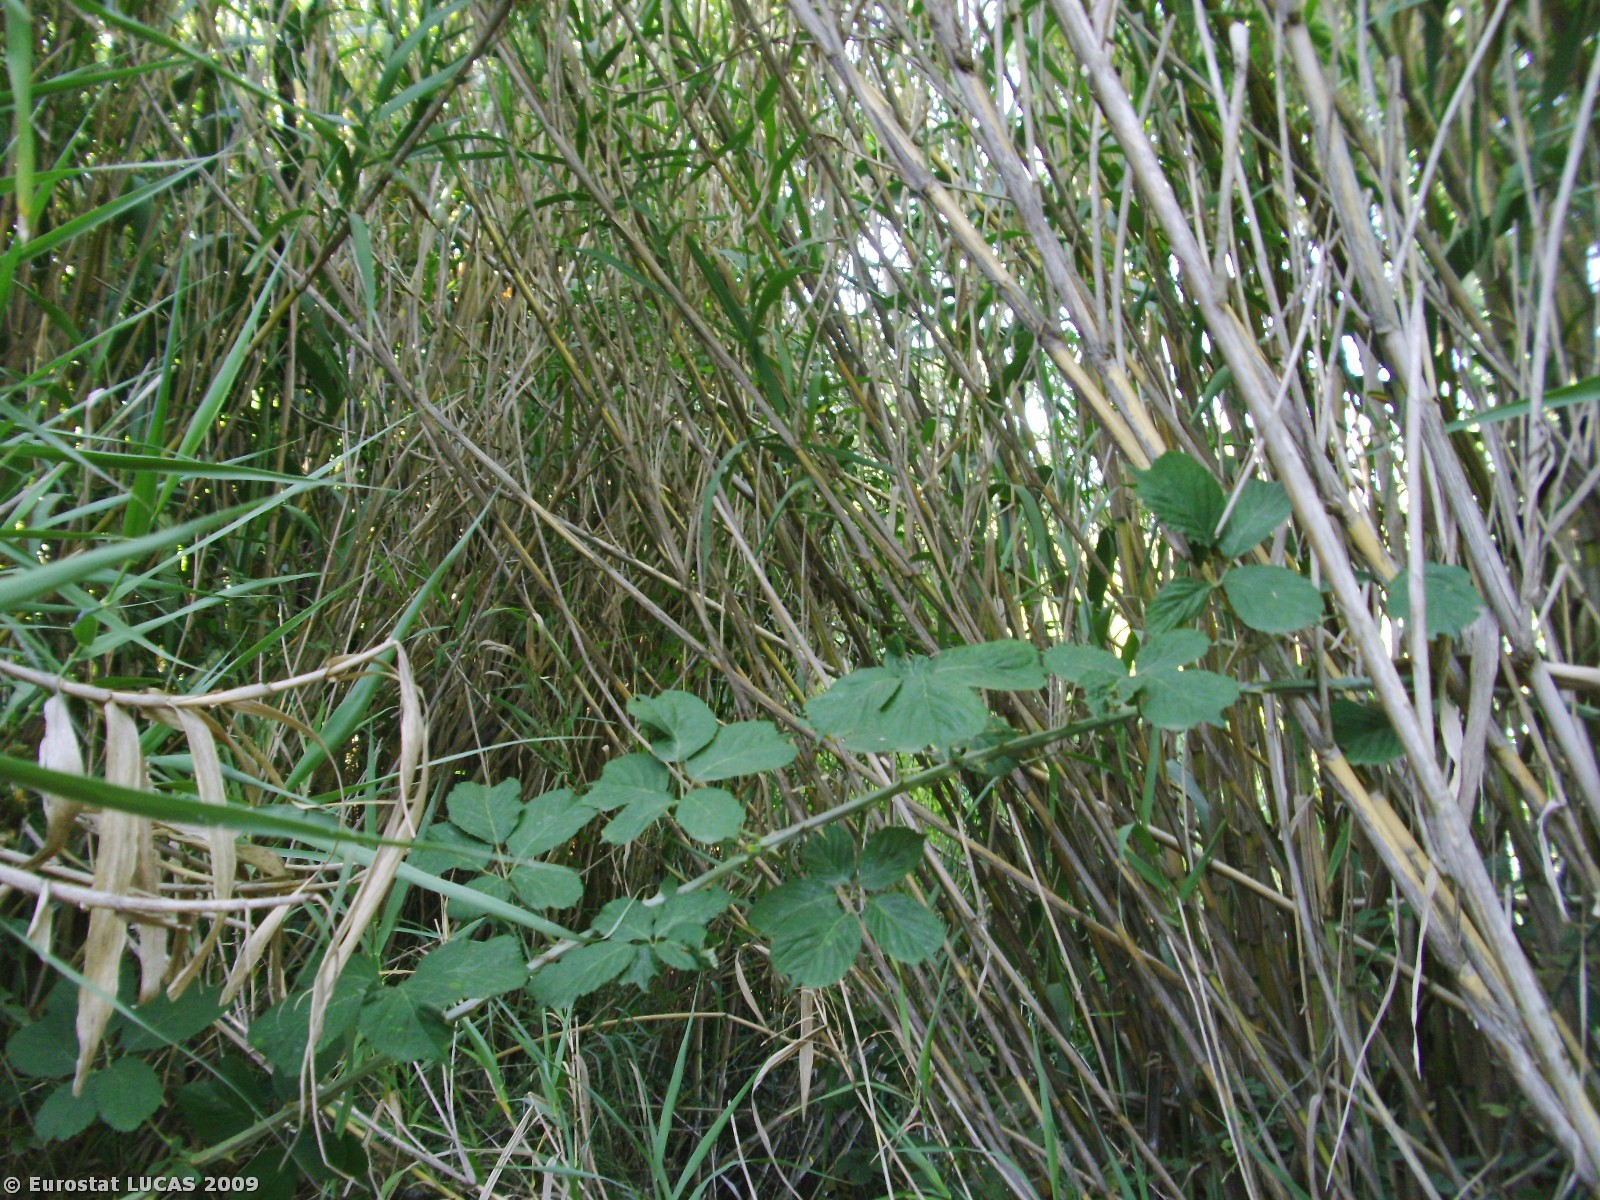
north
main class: Shrubland
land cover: Shrubland with sparse tree cover
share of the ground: > 75 %
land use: Fallow land
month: July
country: PT
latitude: 38.9957
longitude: -9.3099
